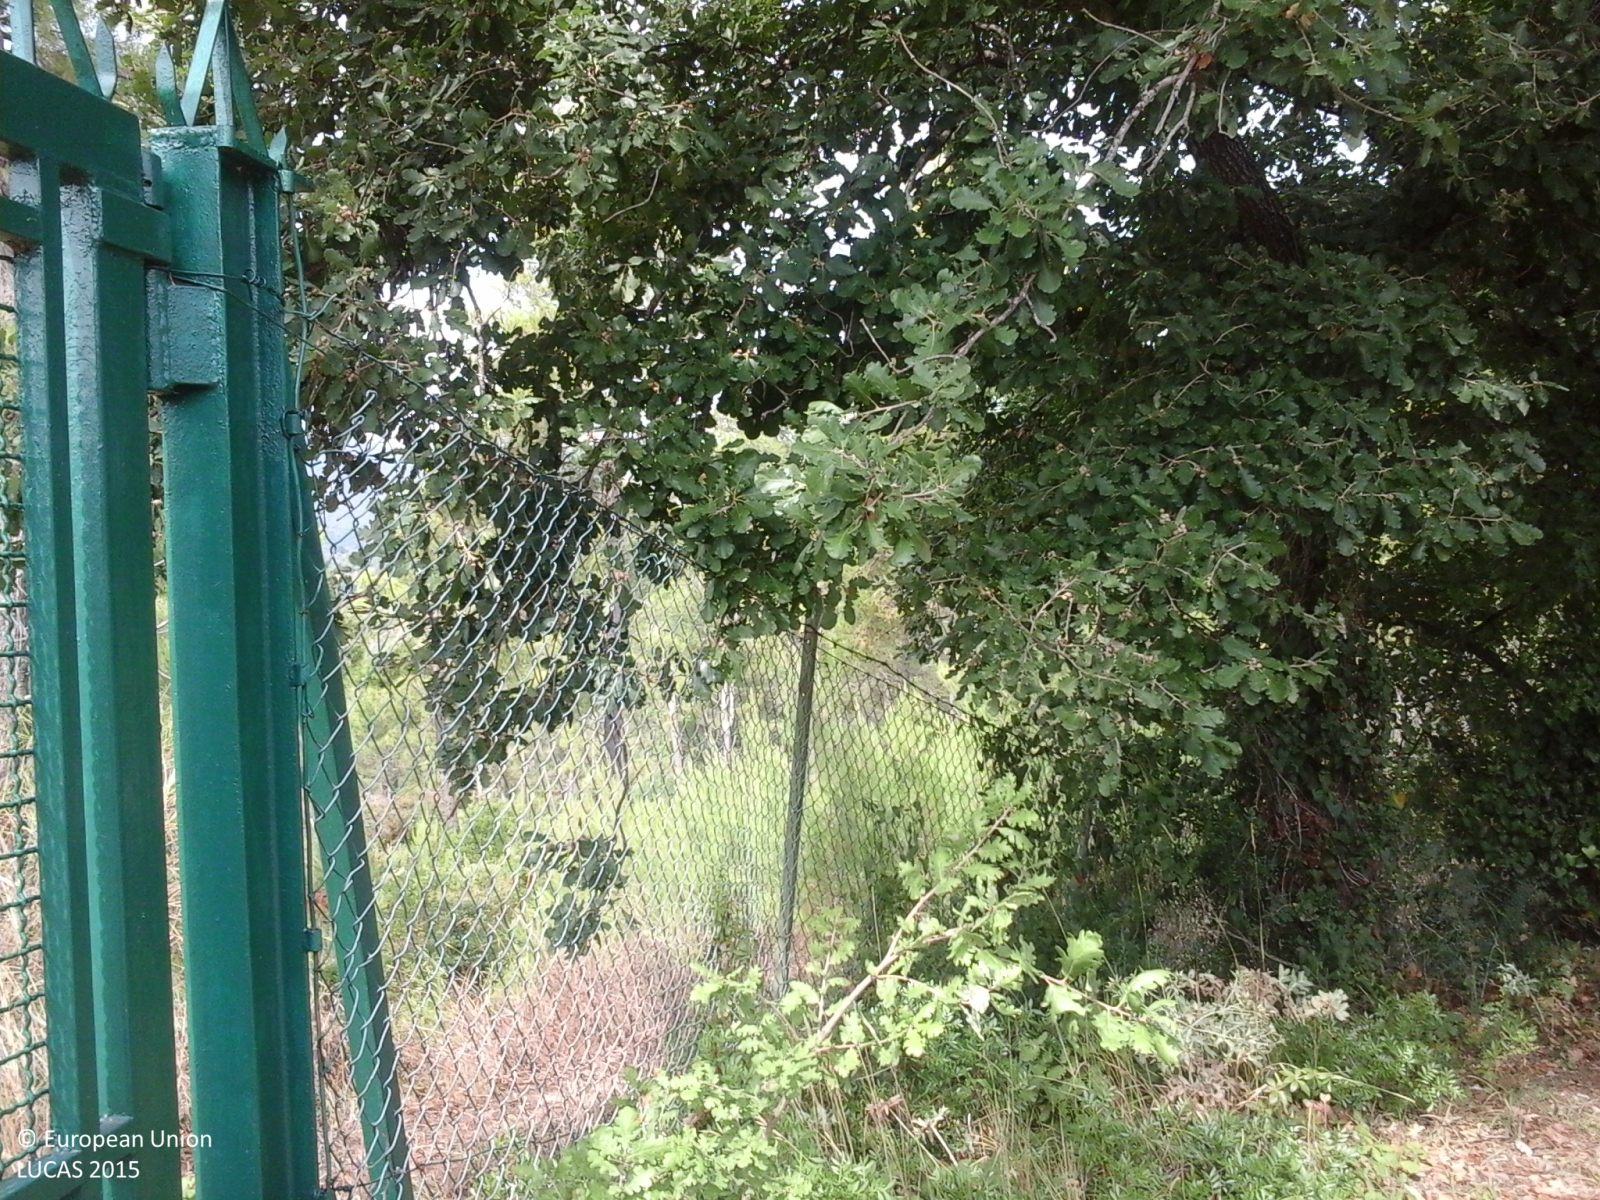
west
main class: Woodland
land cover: Broadleaved woodland
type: broadleaved evergreen forest
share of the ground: > 75 %
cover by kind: broadleaved forest trees 80 %, coniferous forest trees 20 %
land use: Forestry
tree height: > 5 m
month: August
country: IT
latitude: 42.9023
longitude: 10.9645
